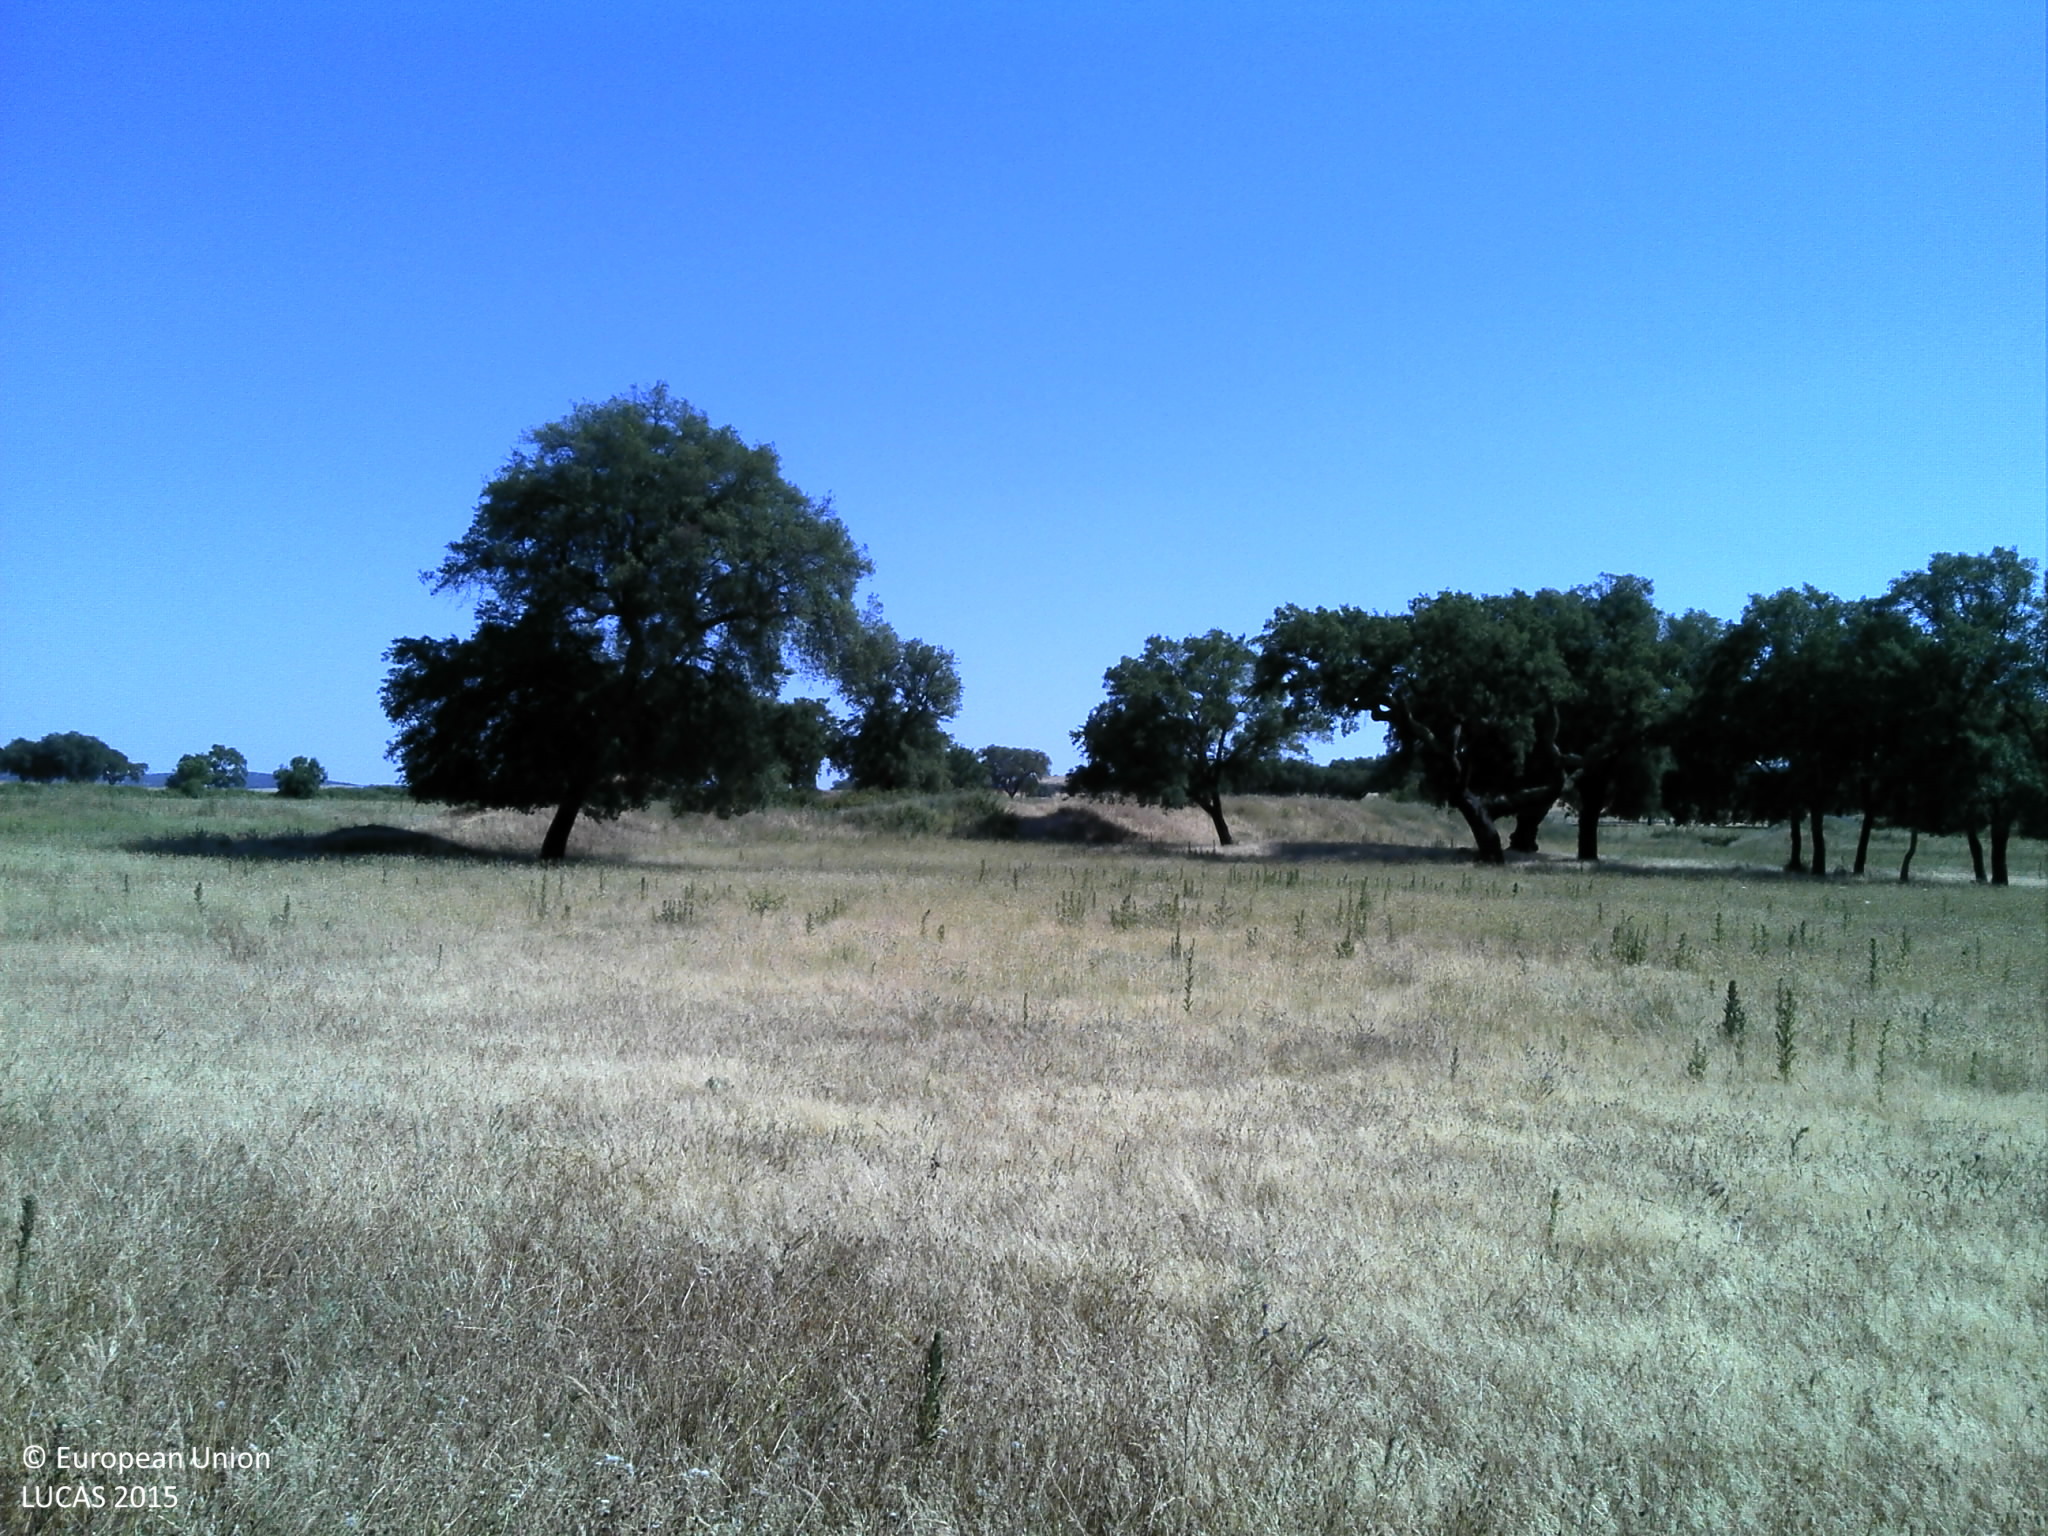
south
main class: Woodland
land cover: Broadleaved woodland
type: broadleaved evergreen forest
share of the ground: > 75 %
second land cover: Grassland without tree/shrub cover
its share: 50 - 75 %
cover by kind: broadleaved forest trees 75 %, herbaceous plants 25 %
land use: Forestry
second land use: Agriculture (excluding fallow land and kitchen gardens)
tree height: > 5 m
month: June
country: PT
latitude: 38.6827
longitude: -8.1767
